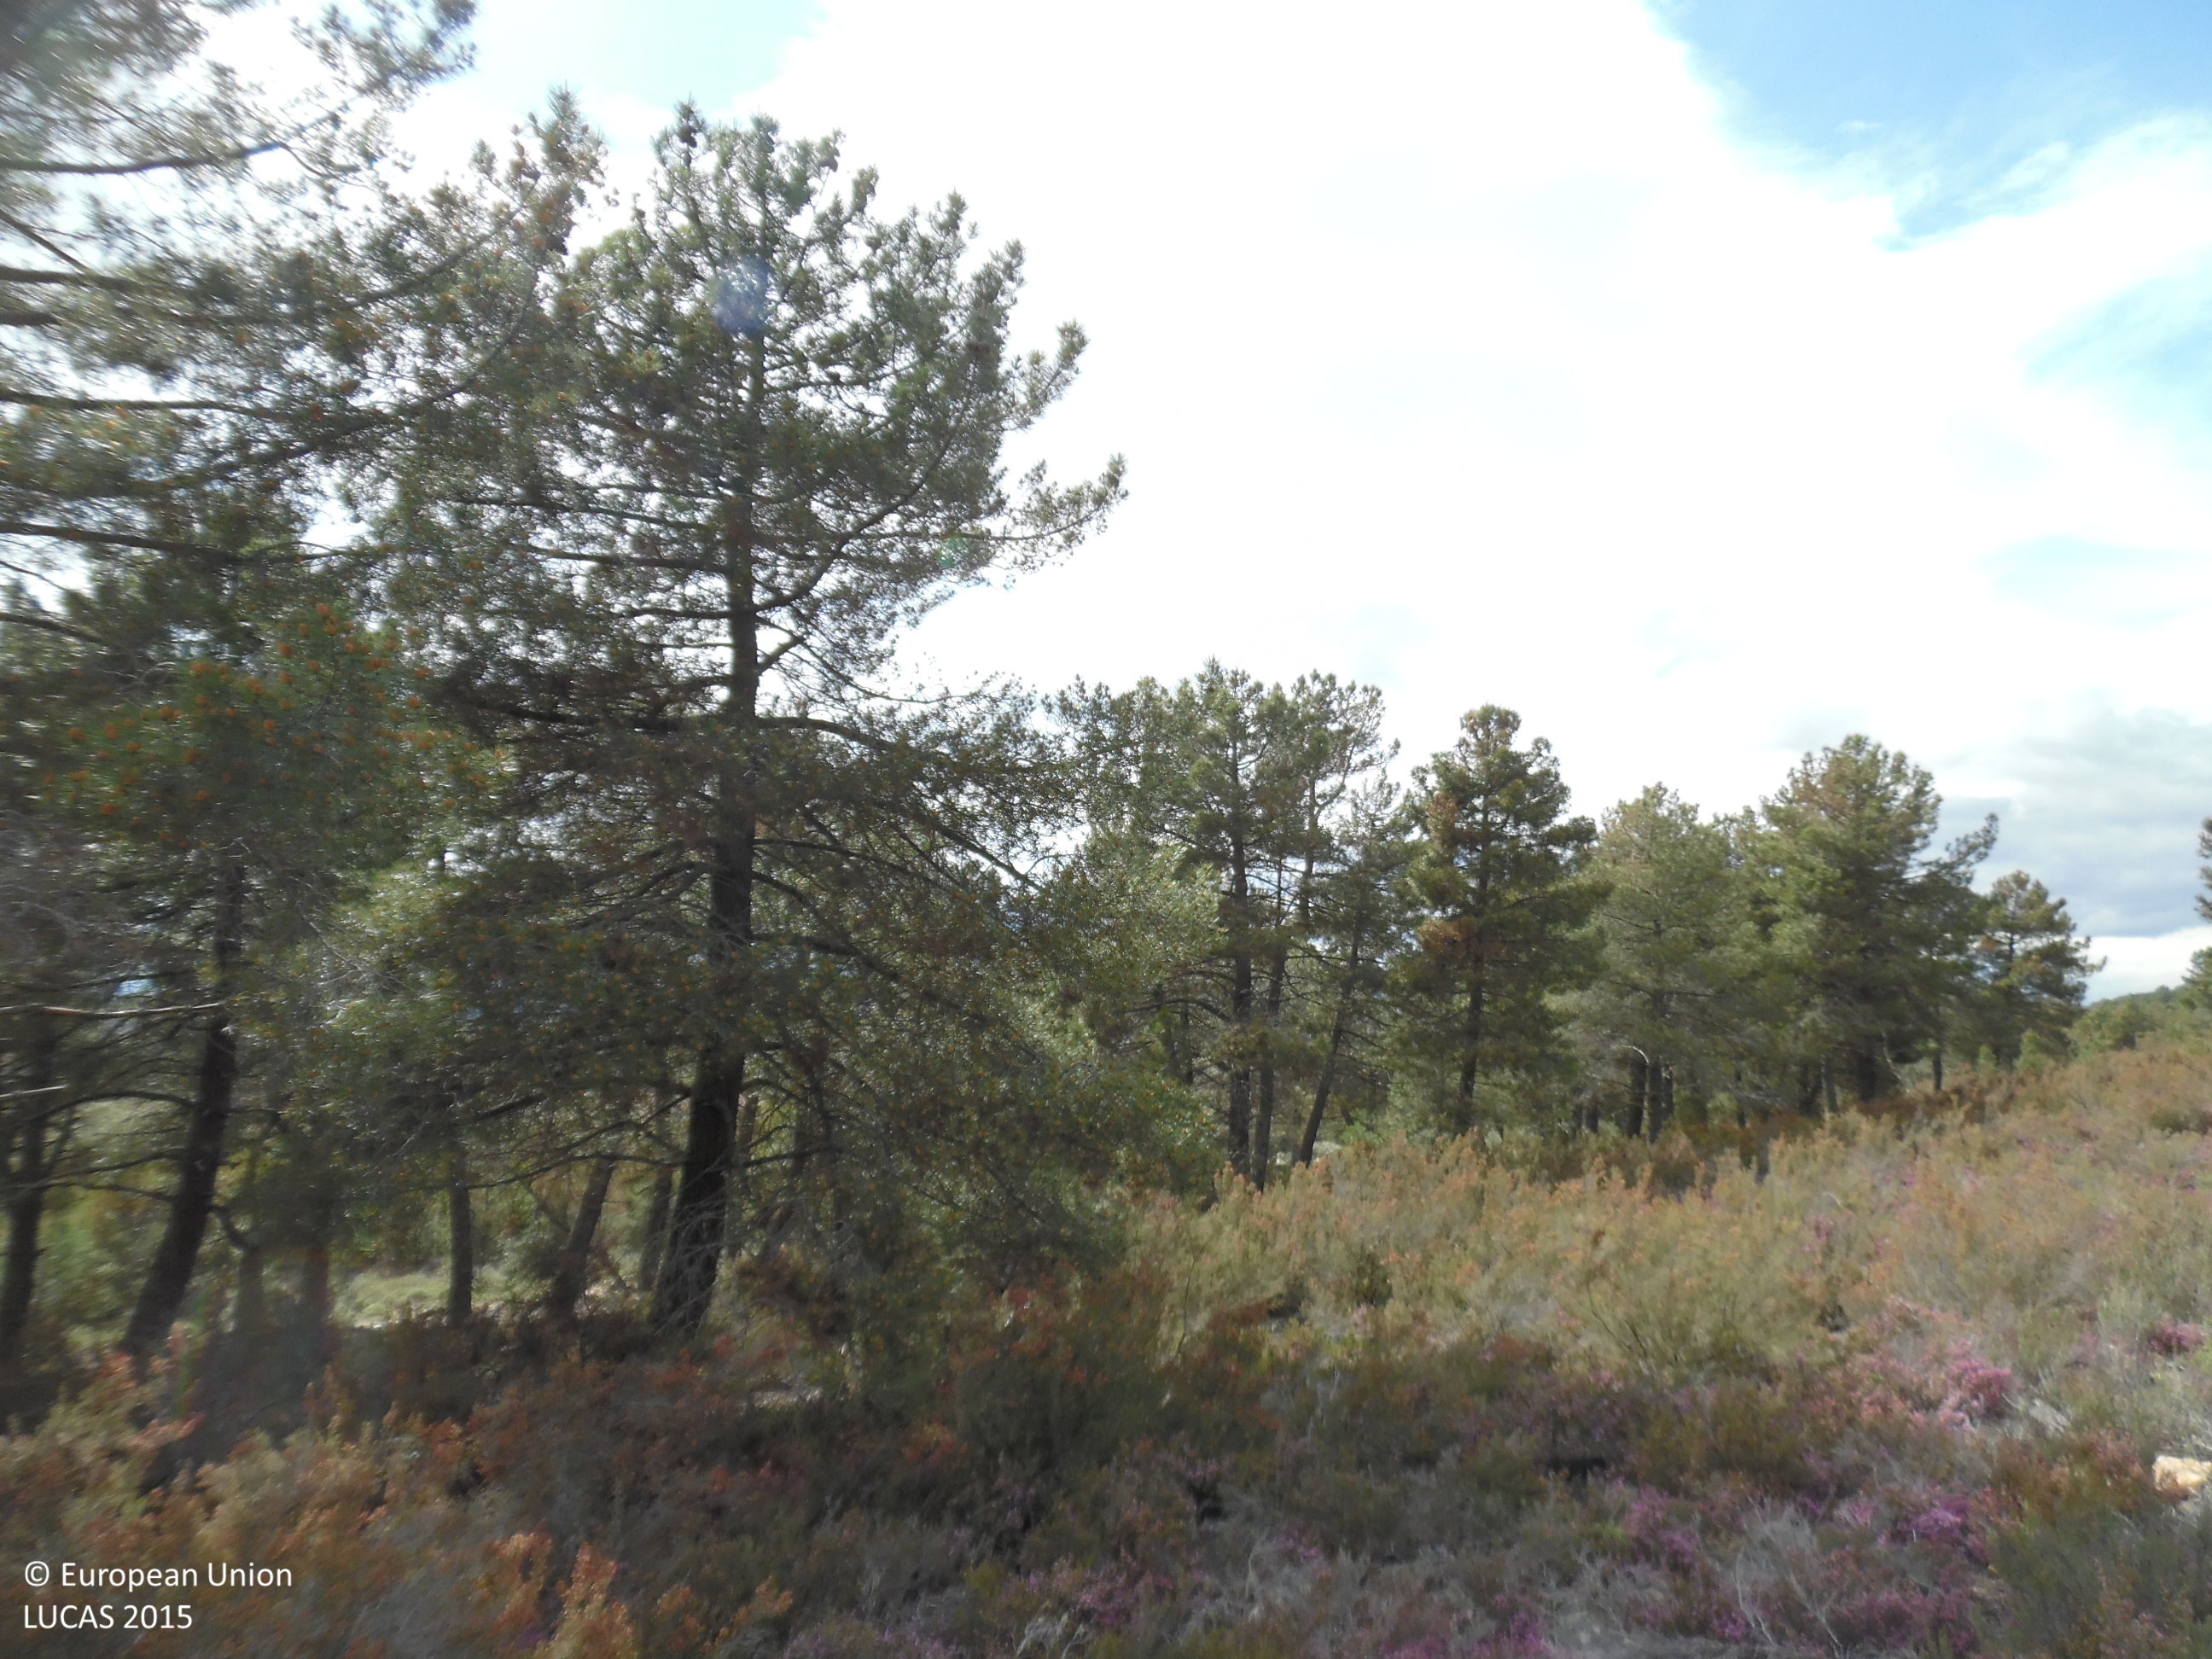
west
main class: Shrubland
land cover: Shrubland with sparse tree cover
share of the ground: > 75 %
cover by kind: shrubs 95 %, coniferous forest trees 5 %
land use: Forestry
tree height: > 5 m
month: April
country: ES
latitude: 42.1737
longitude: -6.0452
